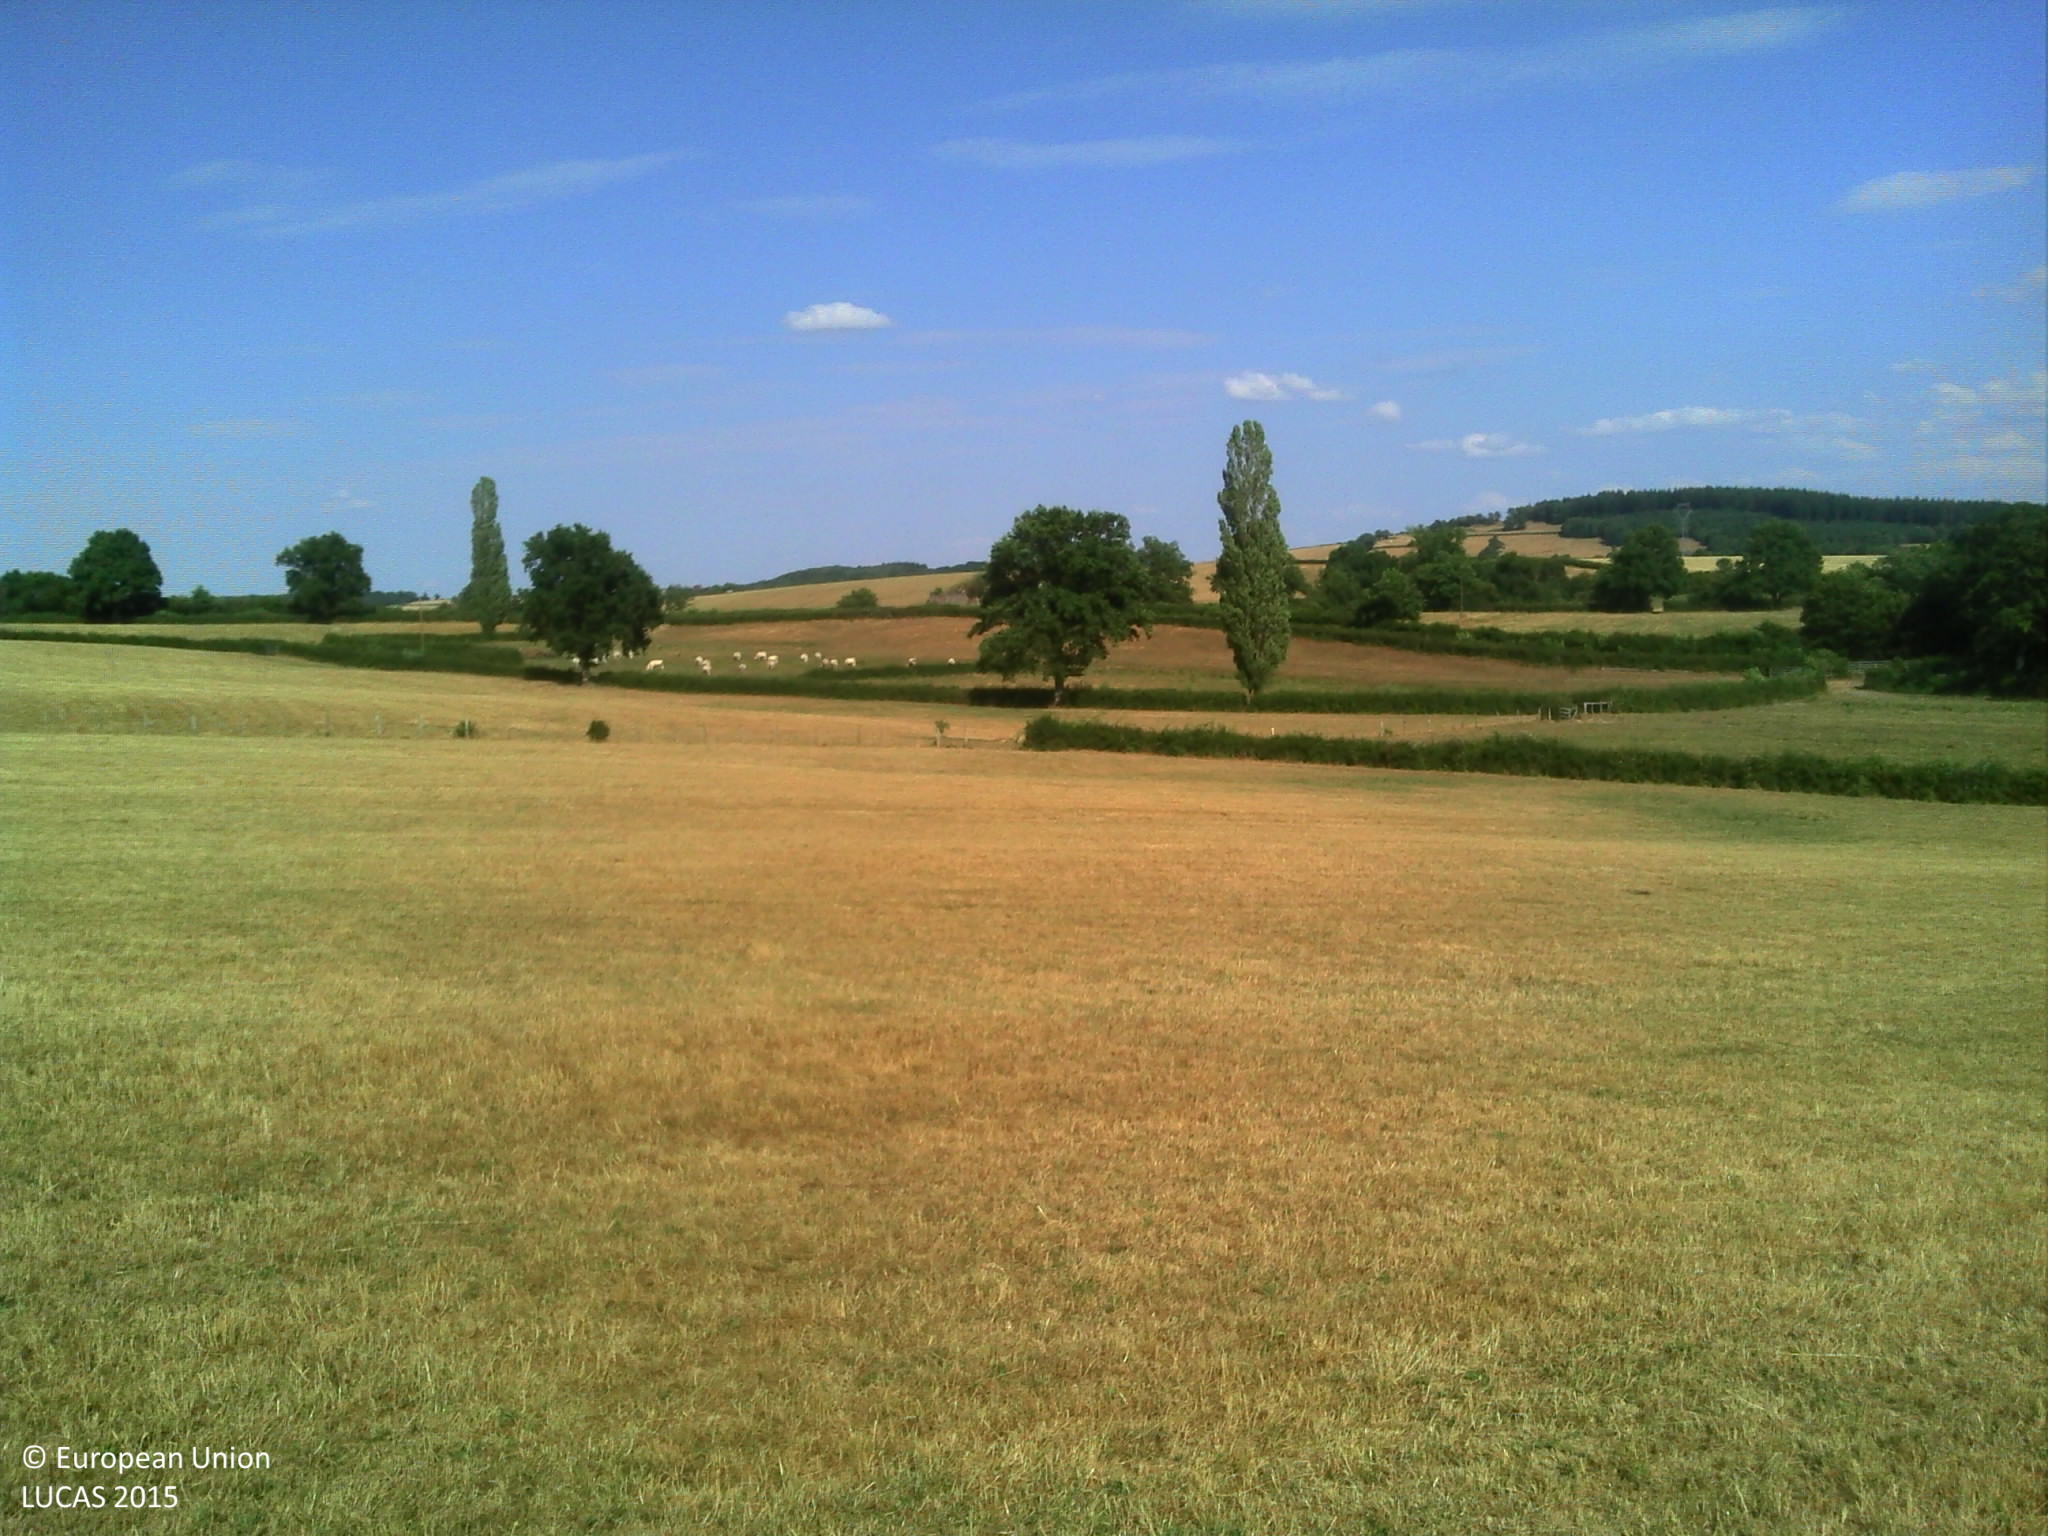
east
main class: Grassland
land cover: Grassland without tree/shrub cover
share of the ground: > 75 %
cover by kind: herbaceous plants 100 %
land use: Agriculture (excluding fallow land and kitchen gardens)
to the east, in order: Grassland without tree/shrub cover; Fences; Grassland without tree/shrub cover; Managed hedges; Single bushes/trees; Fences; Grassland without tree/shrub cover; Managed hedges; Grassland without tree/shrub cover
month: July
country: FR
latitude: 46.5837
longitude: 4.4024
